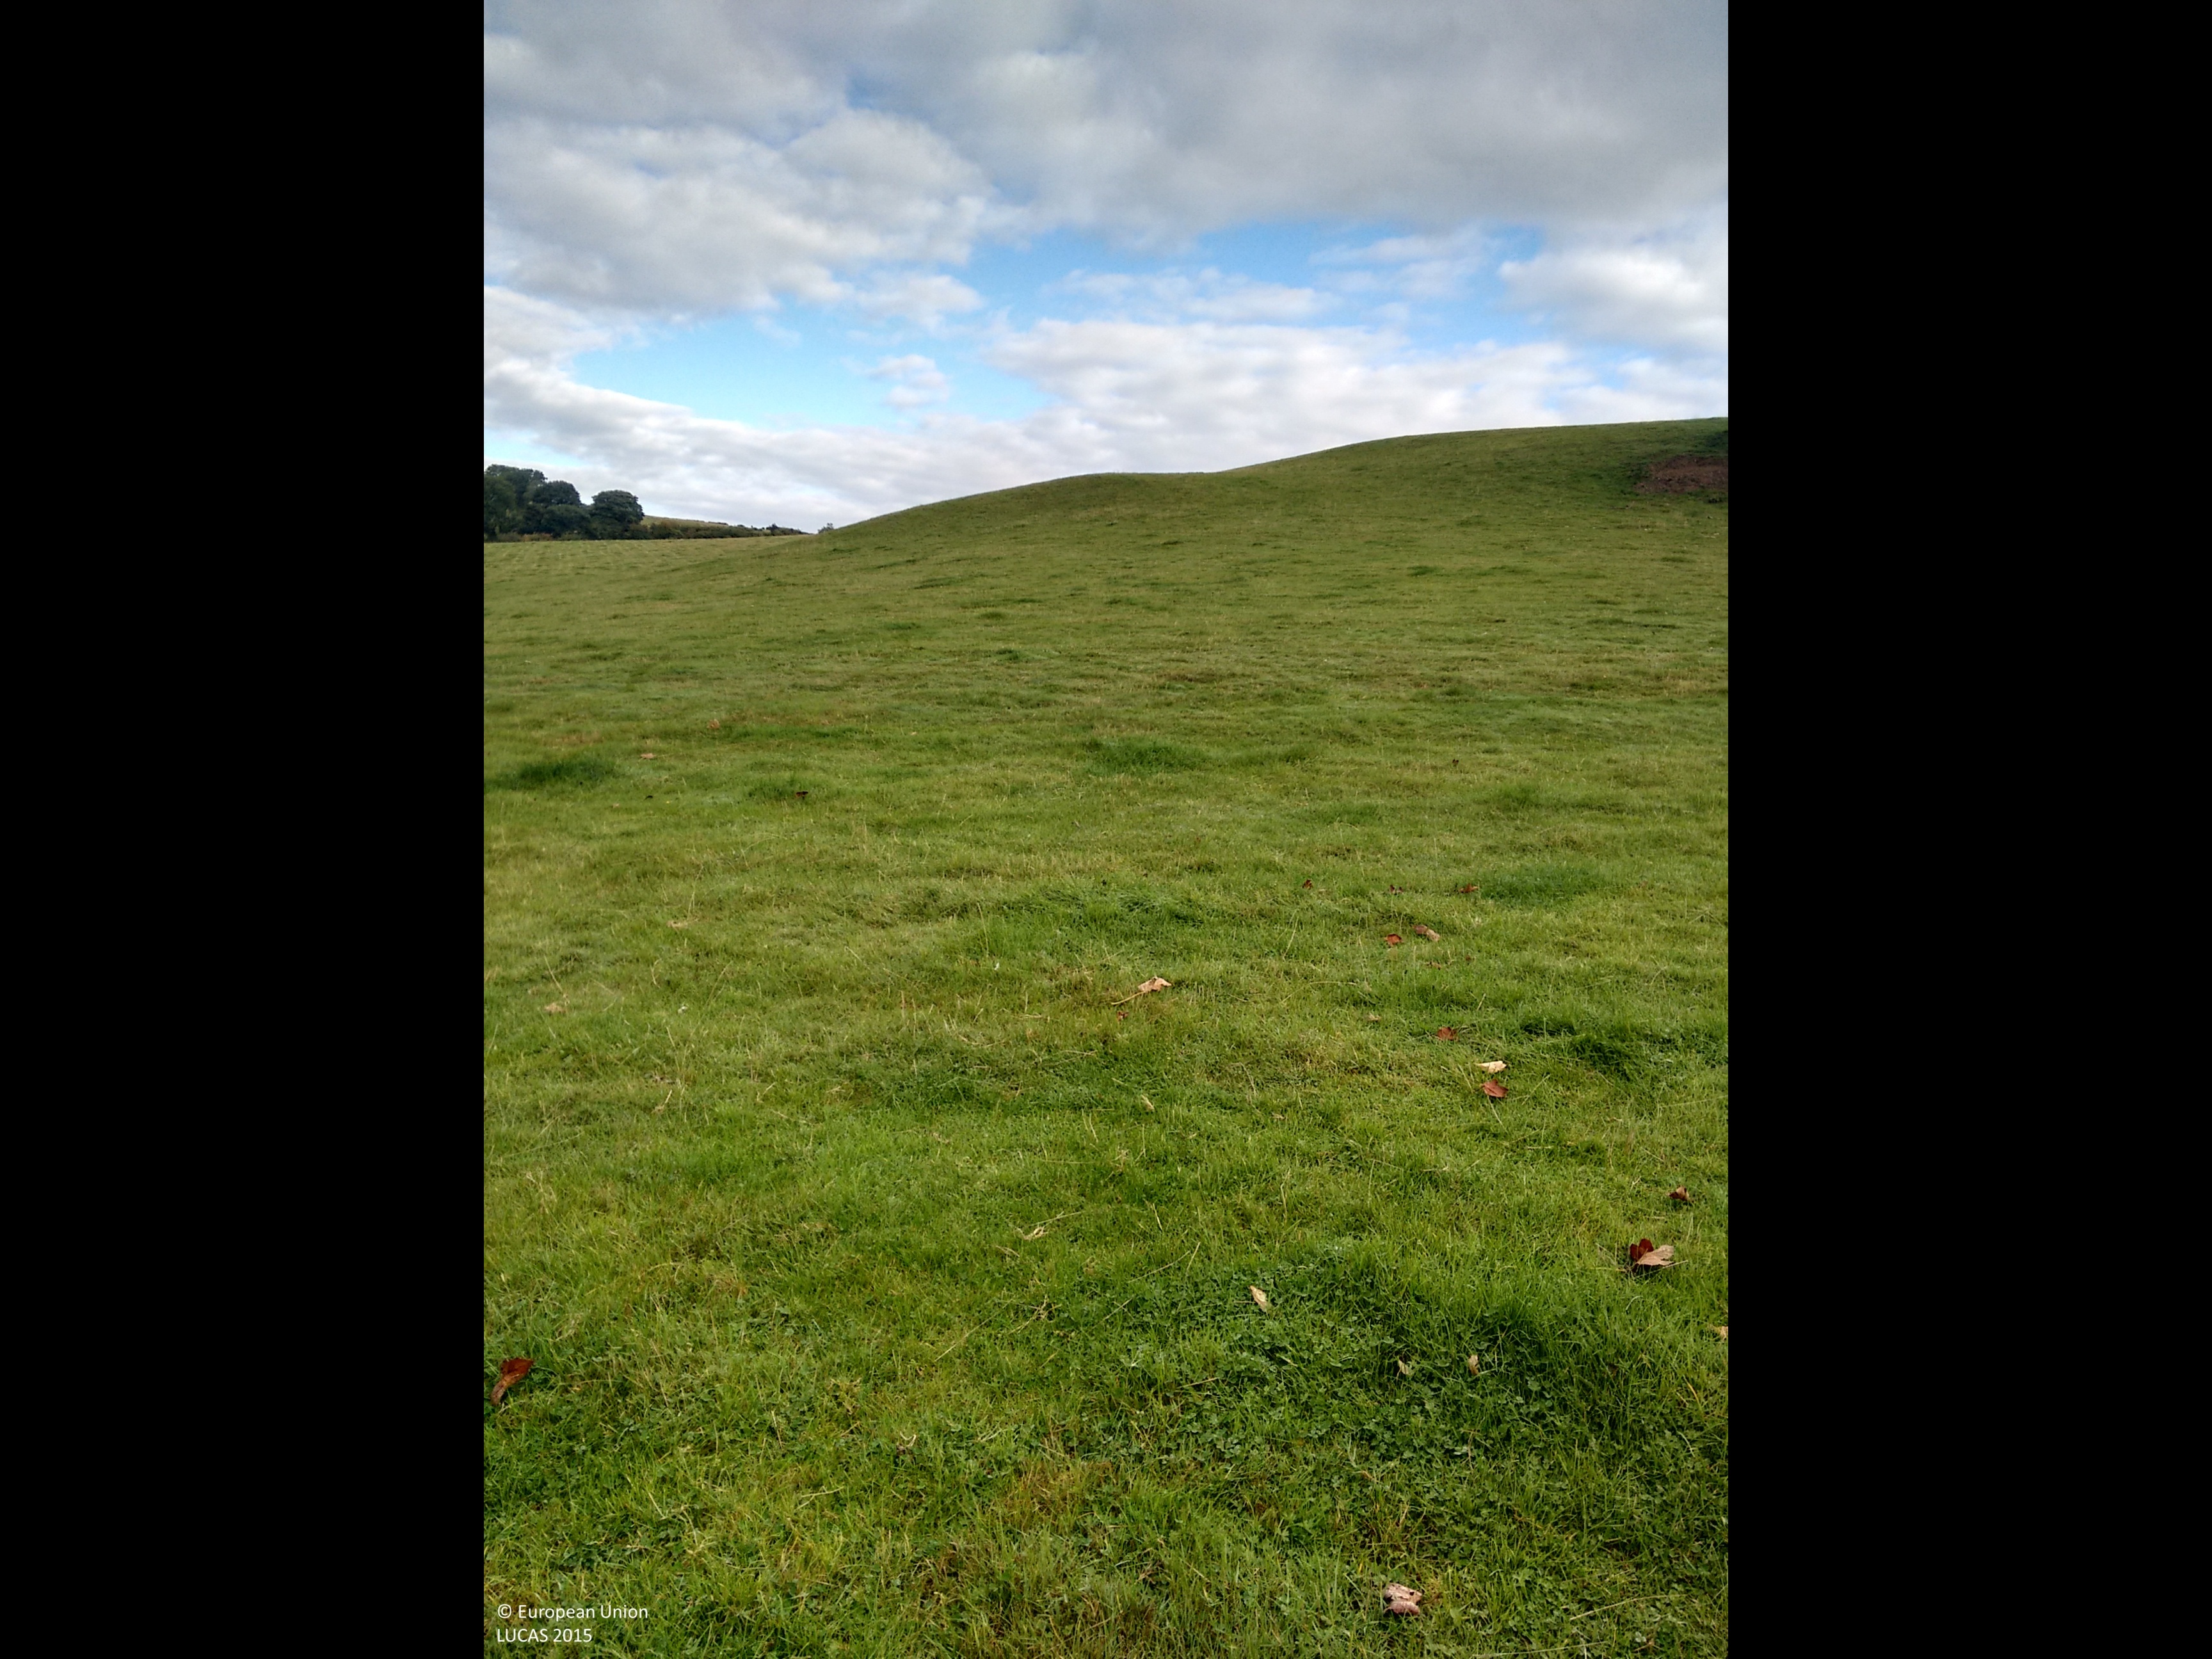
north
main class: Grassland
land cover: Grassland without tree/shrub cover
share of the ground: > 75 %
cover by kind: herbaceous plants 100 %
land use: Agriculture (excluding fallow land and kitchen gardens)
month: September
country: GB
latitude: 53.0038
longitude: -3.3590
